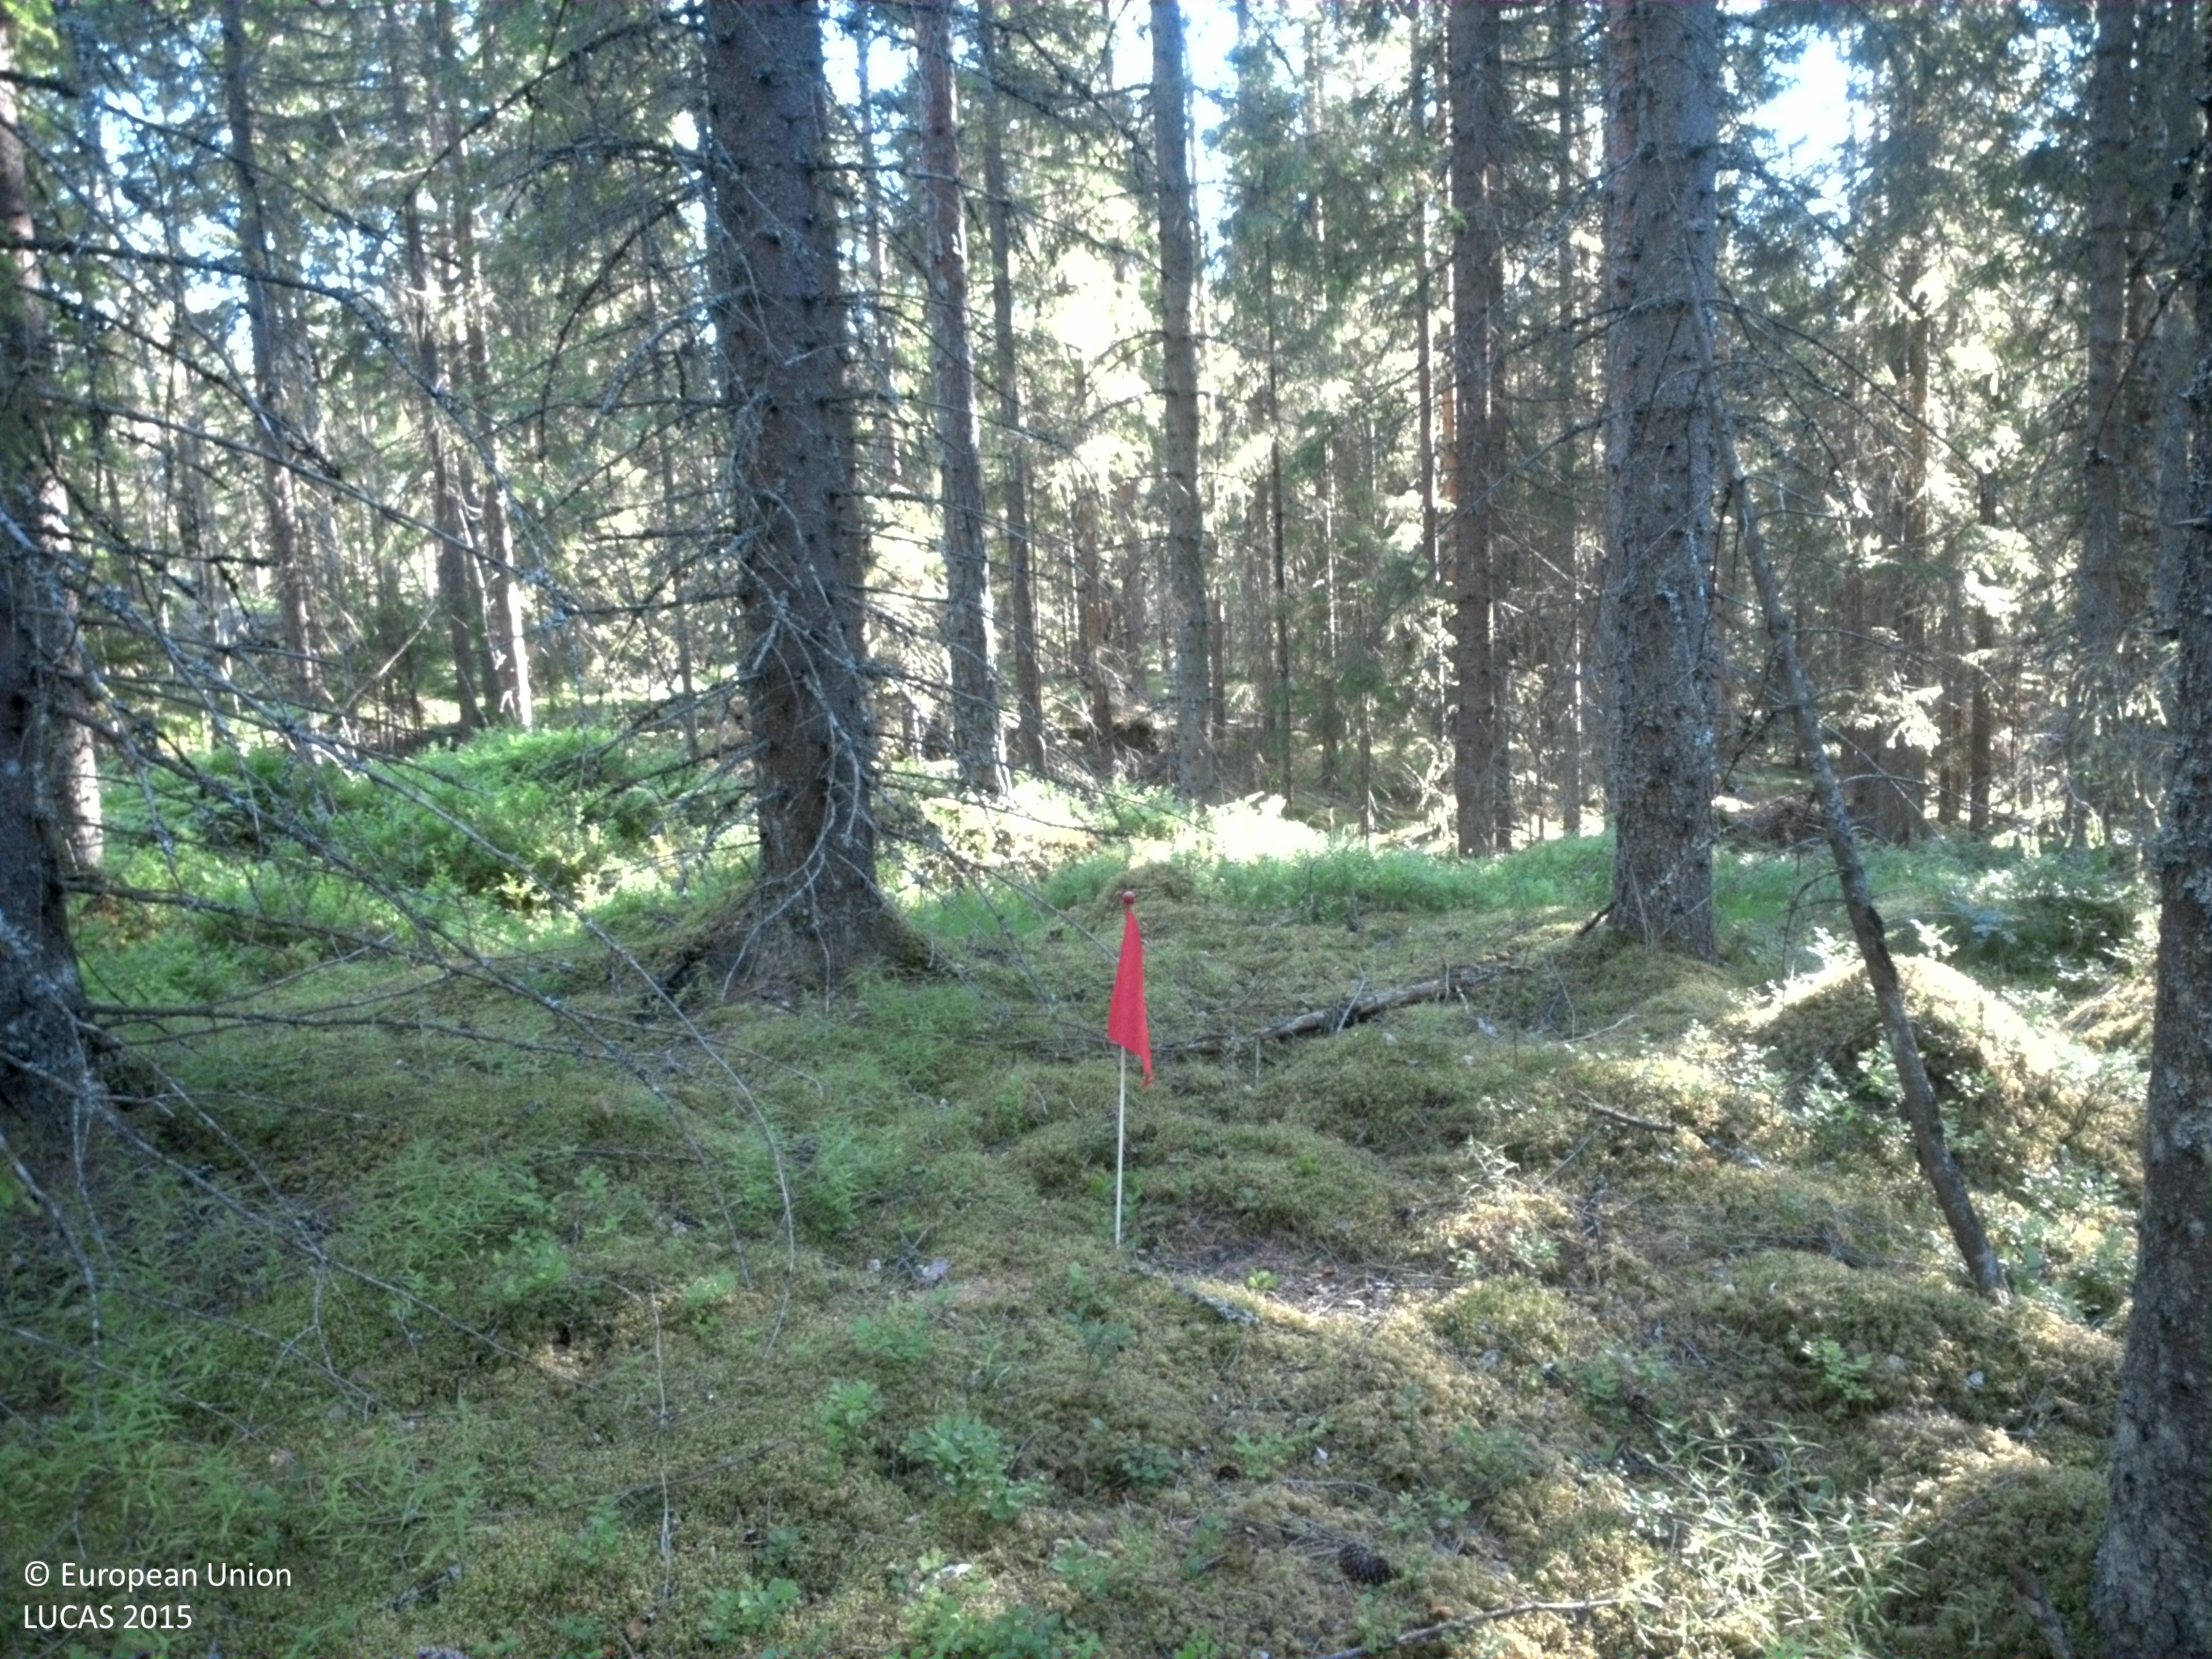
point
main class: Woodland
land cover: Spruce dominated coniferous woodland
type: boreal forest
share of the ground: 50 - 75 %
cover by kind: coniferous forest trees 55 %, lichens and mosses 30 %, shrubs 10 %, broadleaved forest trees 5 %
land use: Forestry
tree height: > 5 m
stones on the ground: 10 - 25 %
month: July
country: SE
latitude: 59.8929
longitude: 12.2277
